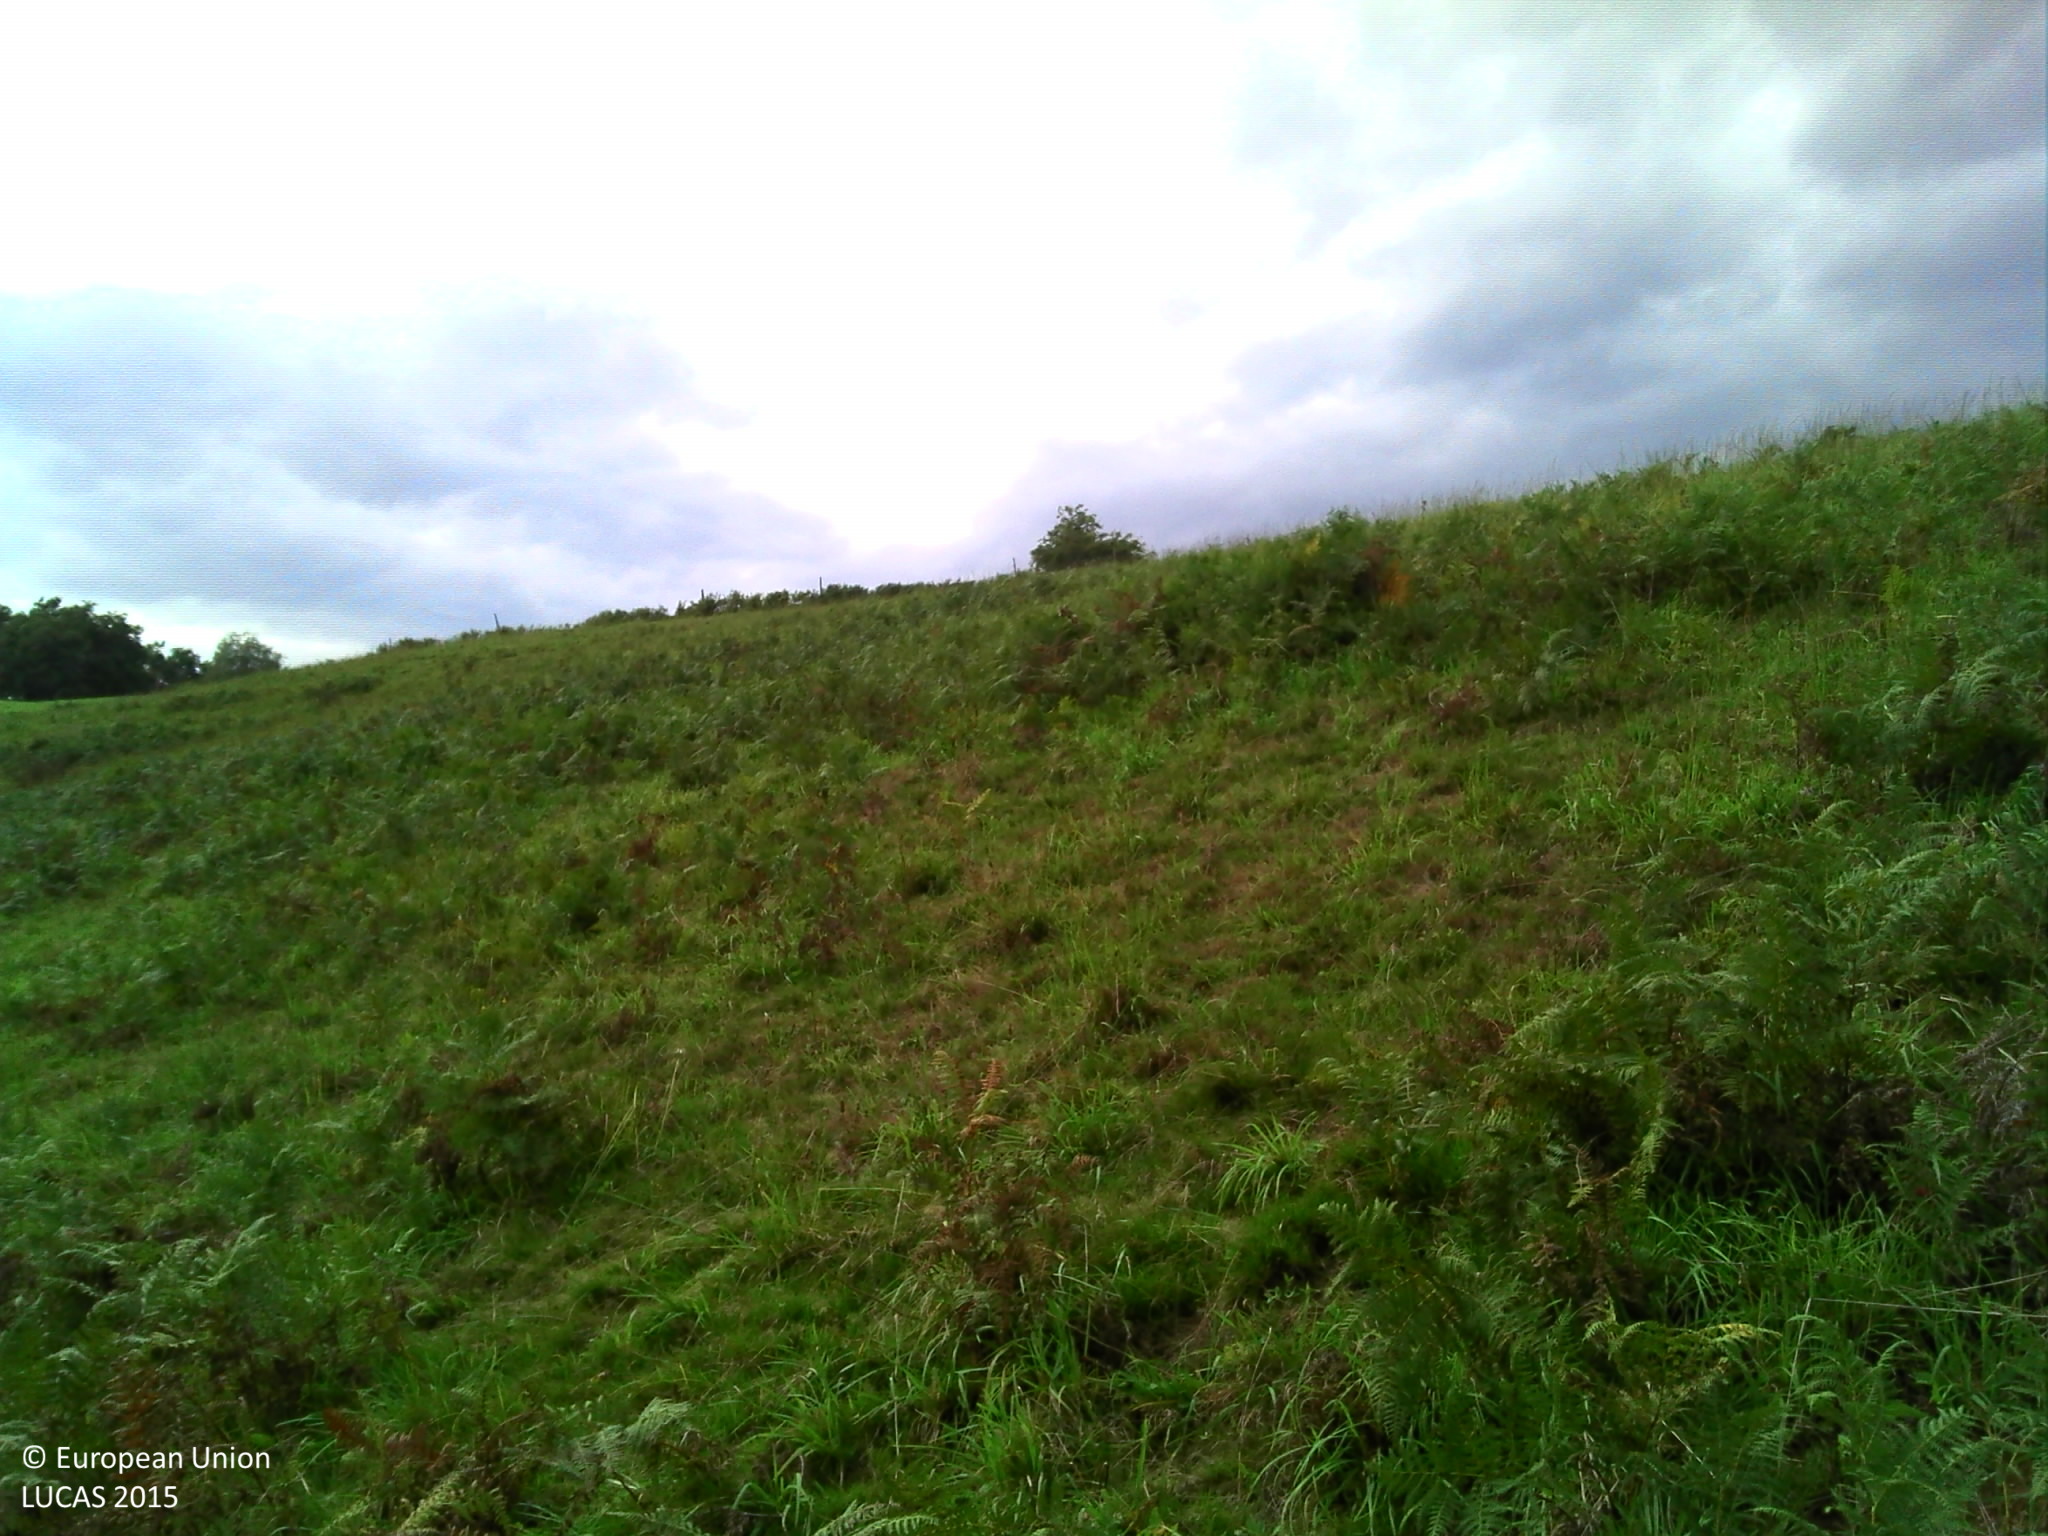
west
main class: Grassland
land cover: Grassland without tree/shrub cover
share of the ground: > 75 %
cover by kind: herbaceous plants 95 %, shrubs 5 %
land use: Agriculture (excluding fallow land and kitchen gardens)
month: September
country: FR
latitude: 43.3942
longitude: -0.7142
